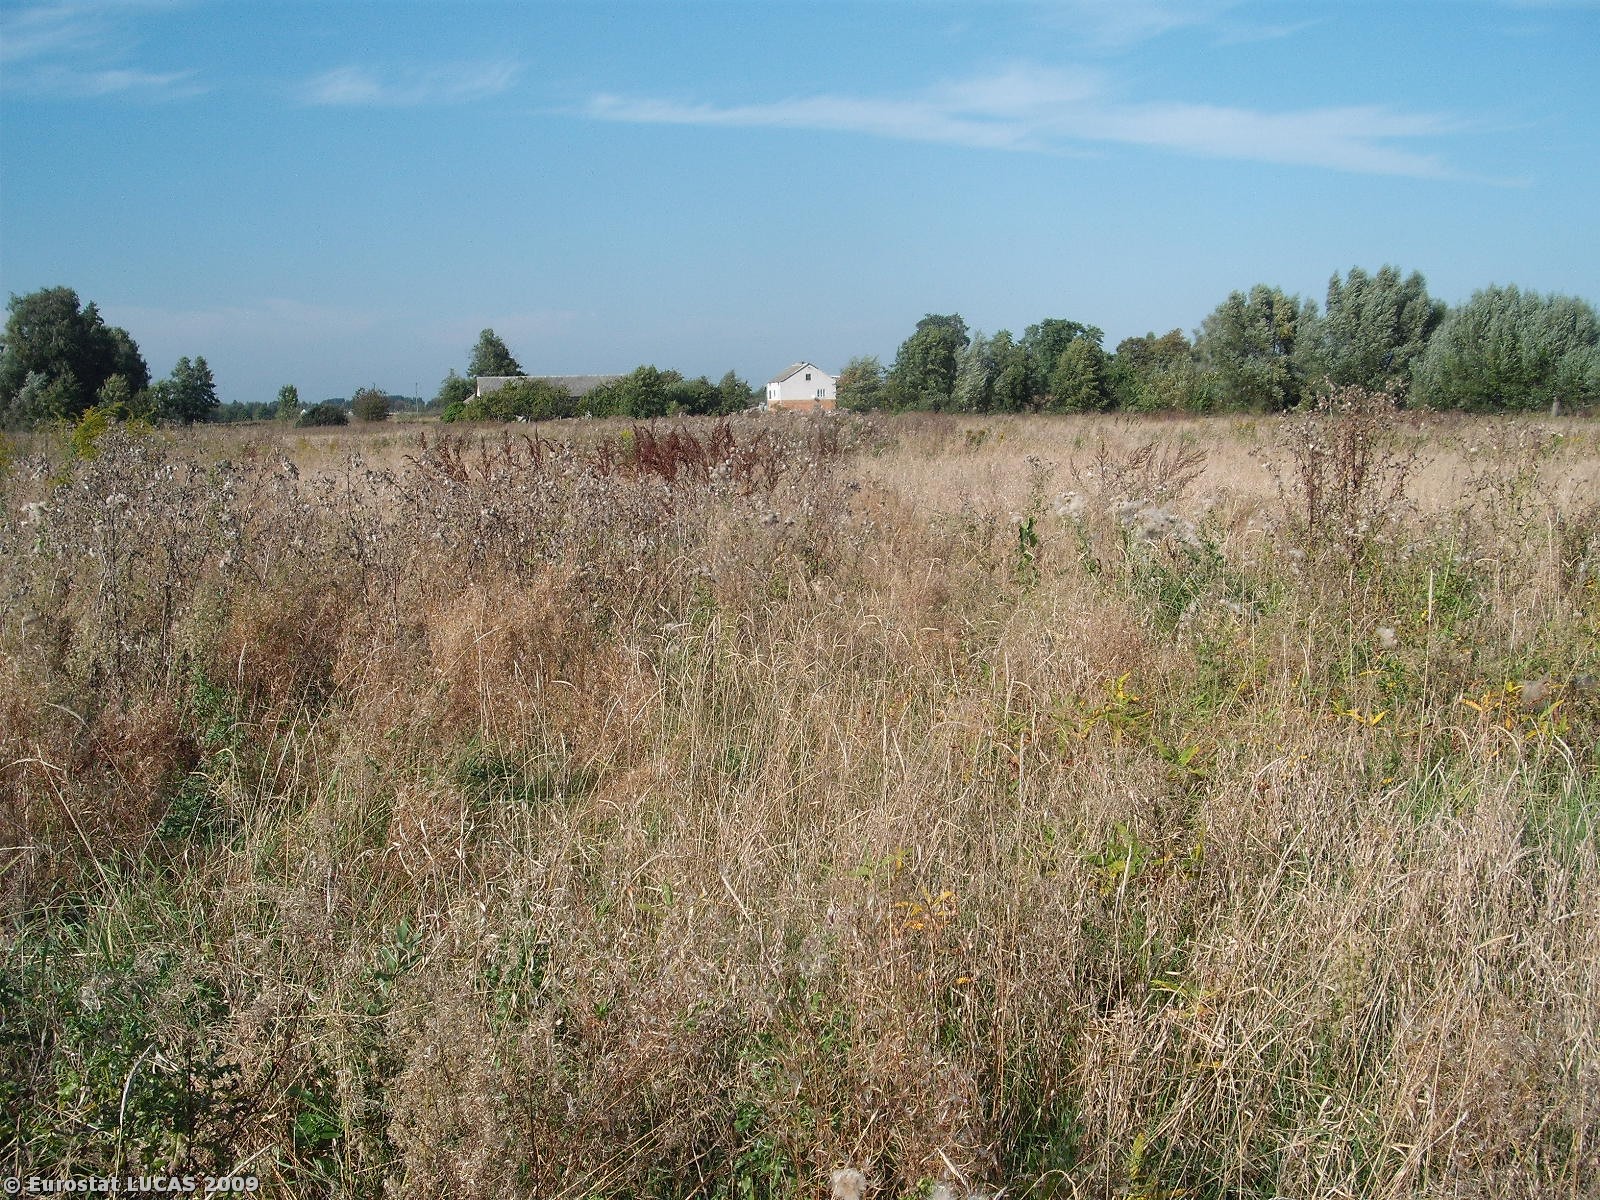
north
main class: Grassland
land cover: Spontaneously vegetated surfaces
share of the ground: > 75 %
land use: Unused
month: September
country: PL
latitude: 51.8460
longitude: 21.0040
